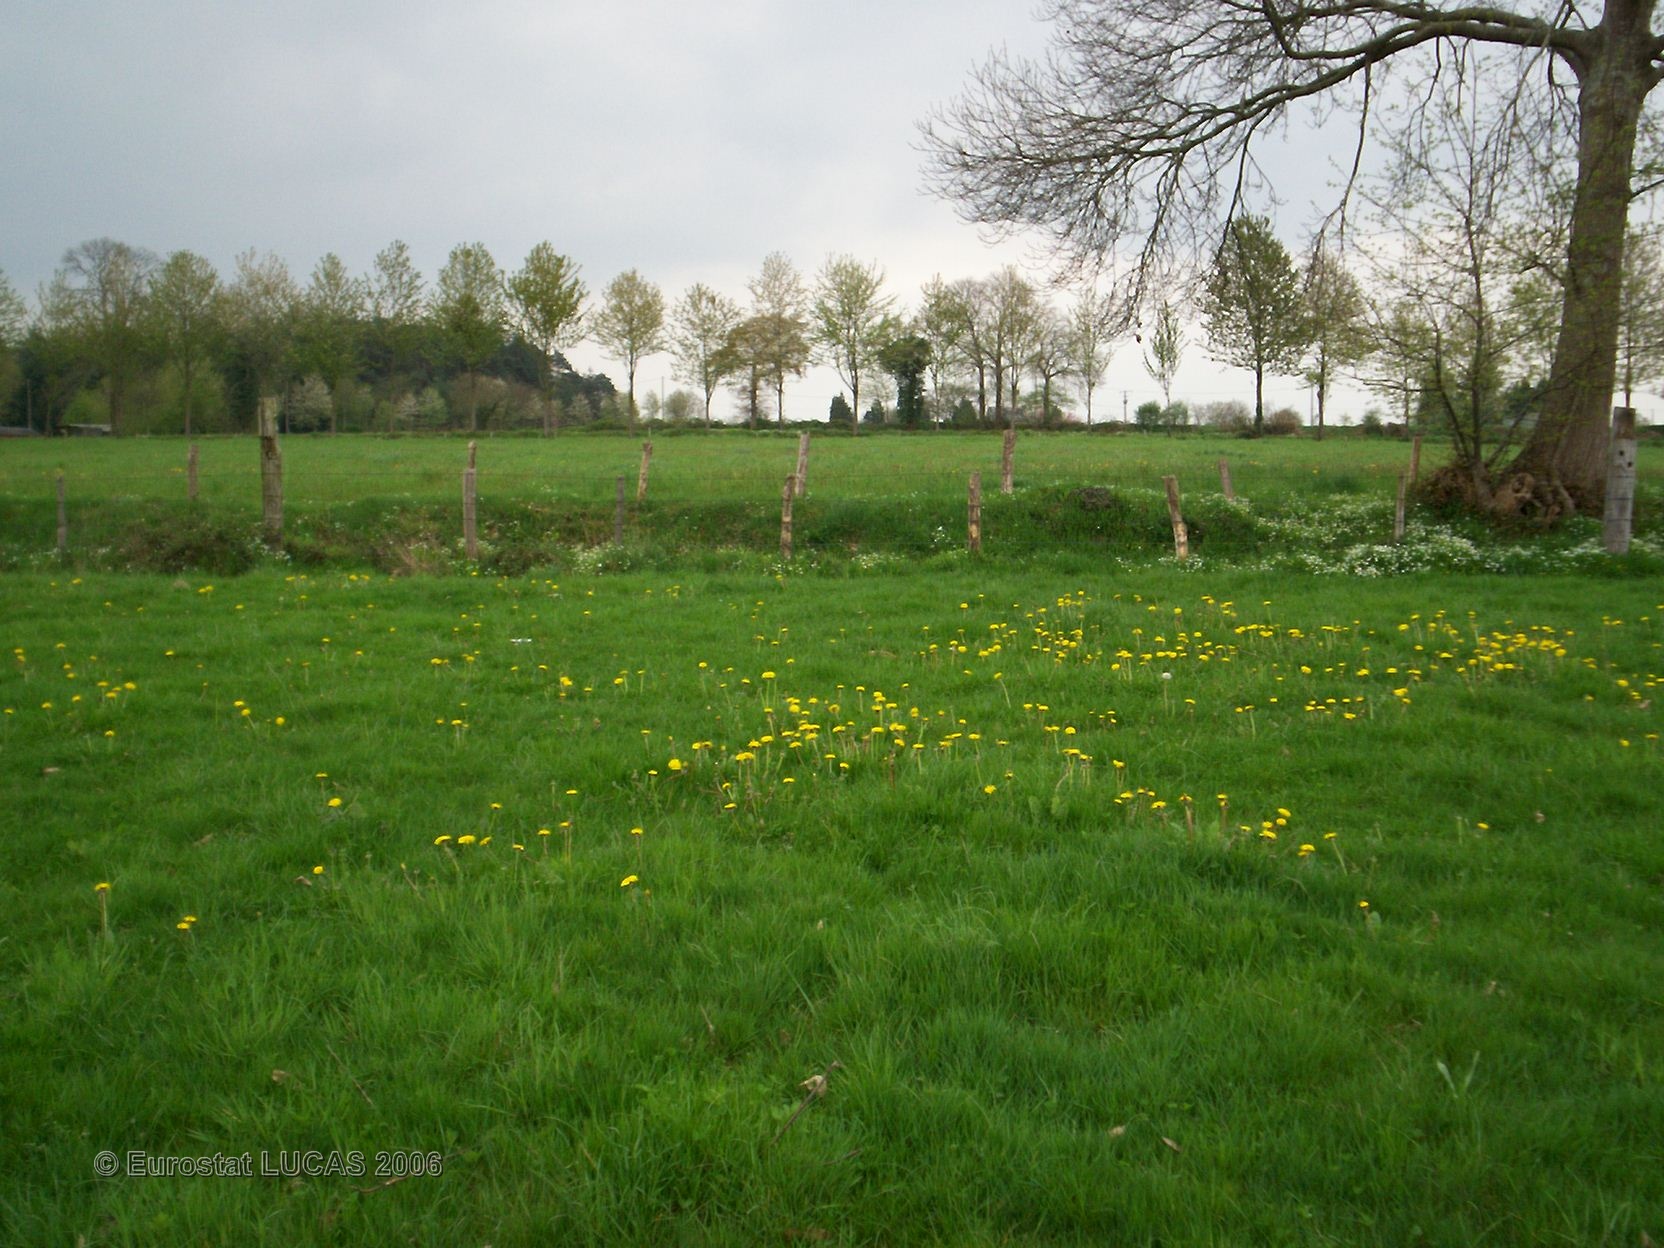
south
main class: Grassland
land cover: Grassland without tree/shrub cover
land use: Agriculture (excluding fallow land and kitchen gardens)
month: April
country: FR
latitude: 48.1976
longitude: -1.3589
